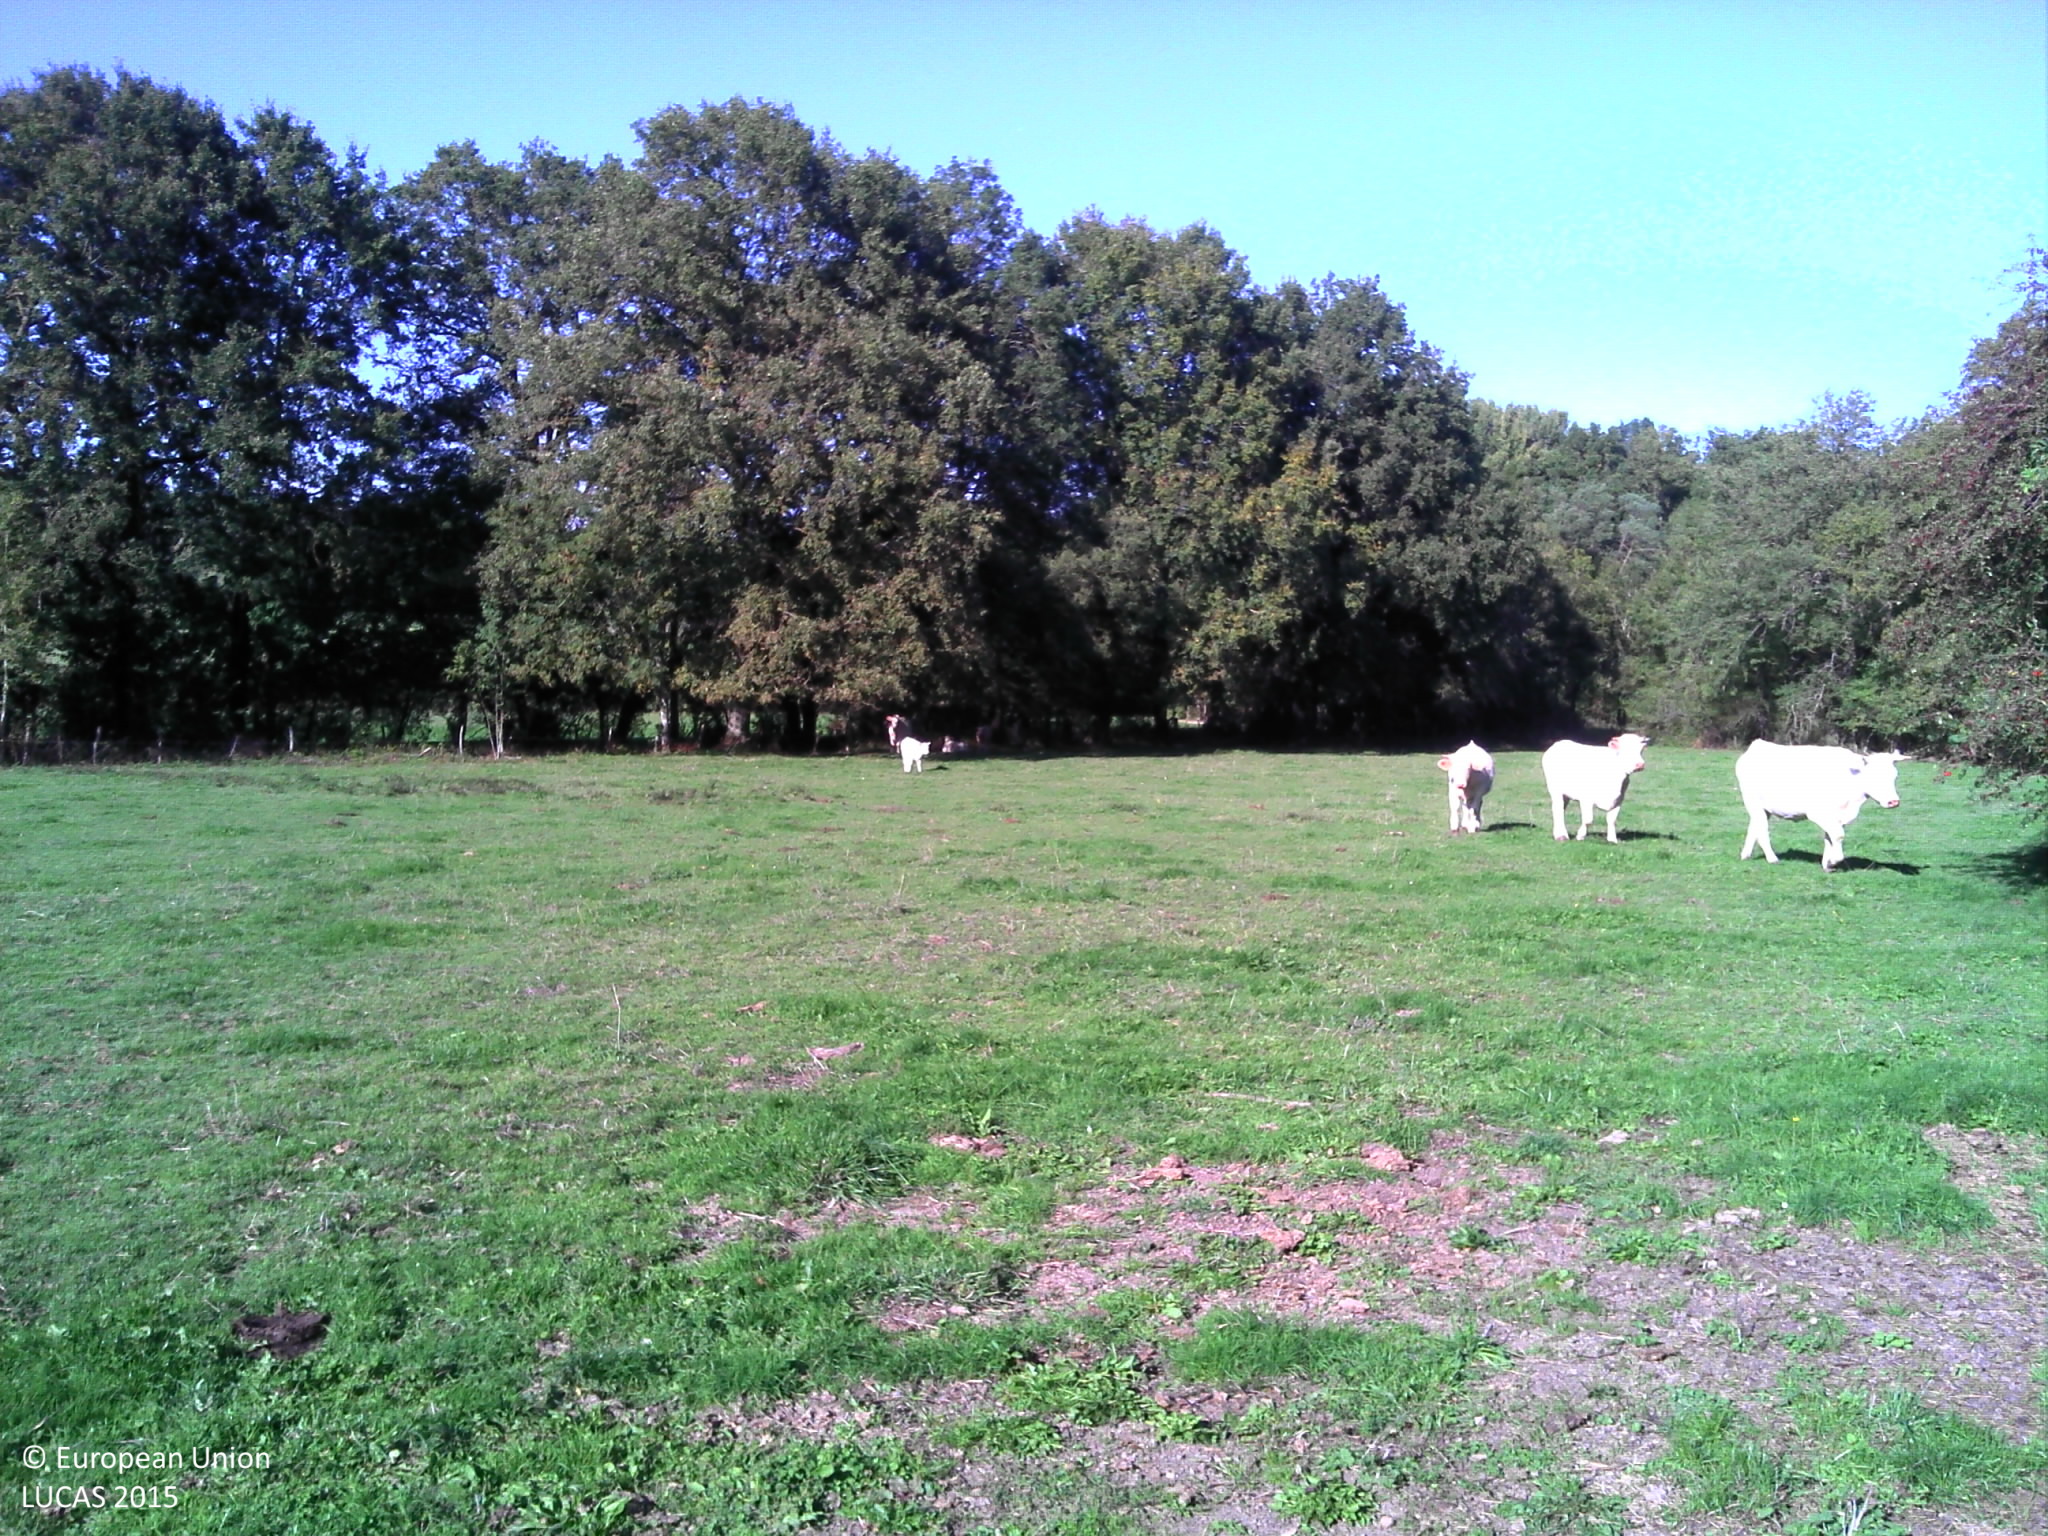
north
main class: Grassland
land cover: Grassland with sparse tree/shrub cover
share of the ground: > 75 %
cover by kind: herbaceous plants 95 %, broadleaved forest trees 5 %
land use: Agriculture (excluding fallow land and kitchen gardens)
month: September
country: FR
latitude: 48.0721
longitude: 3.8895
